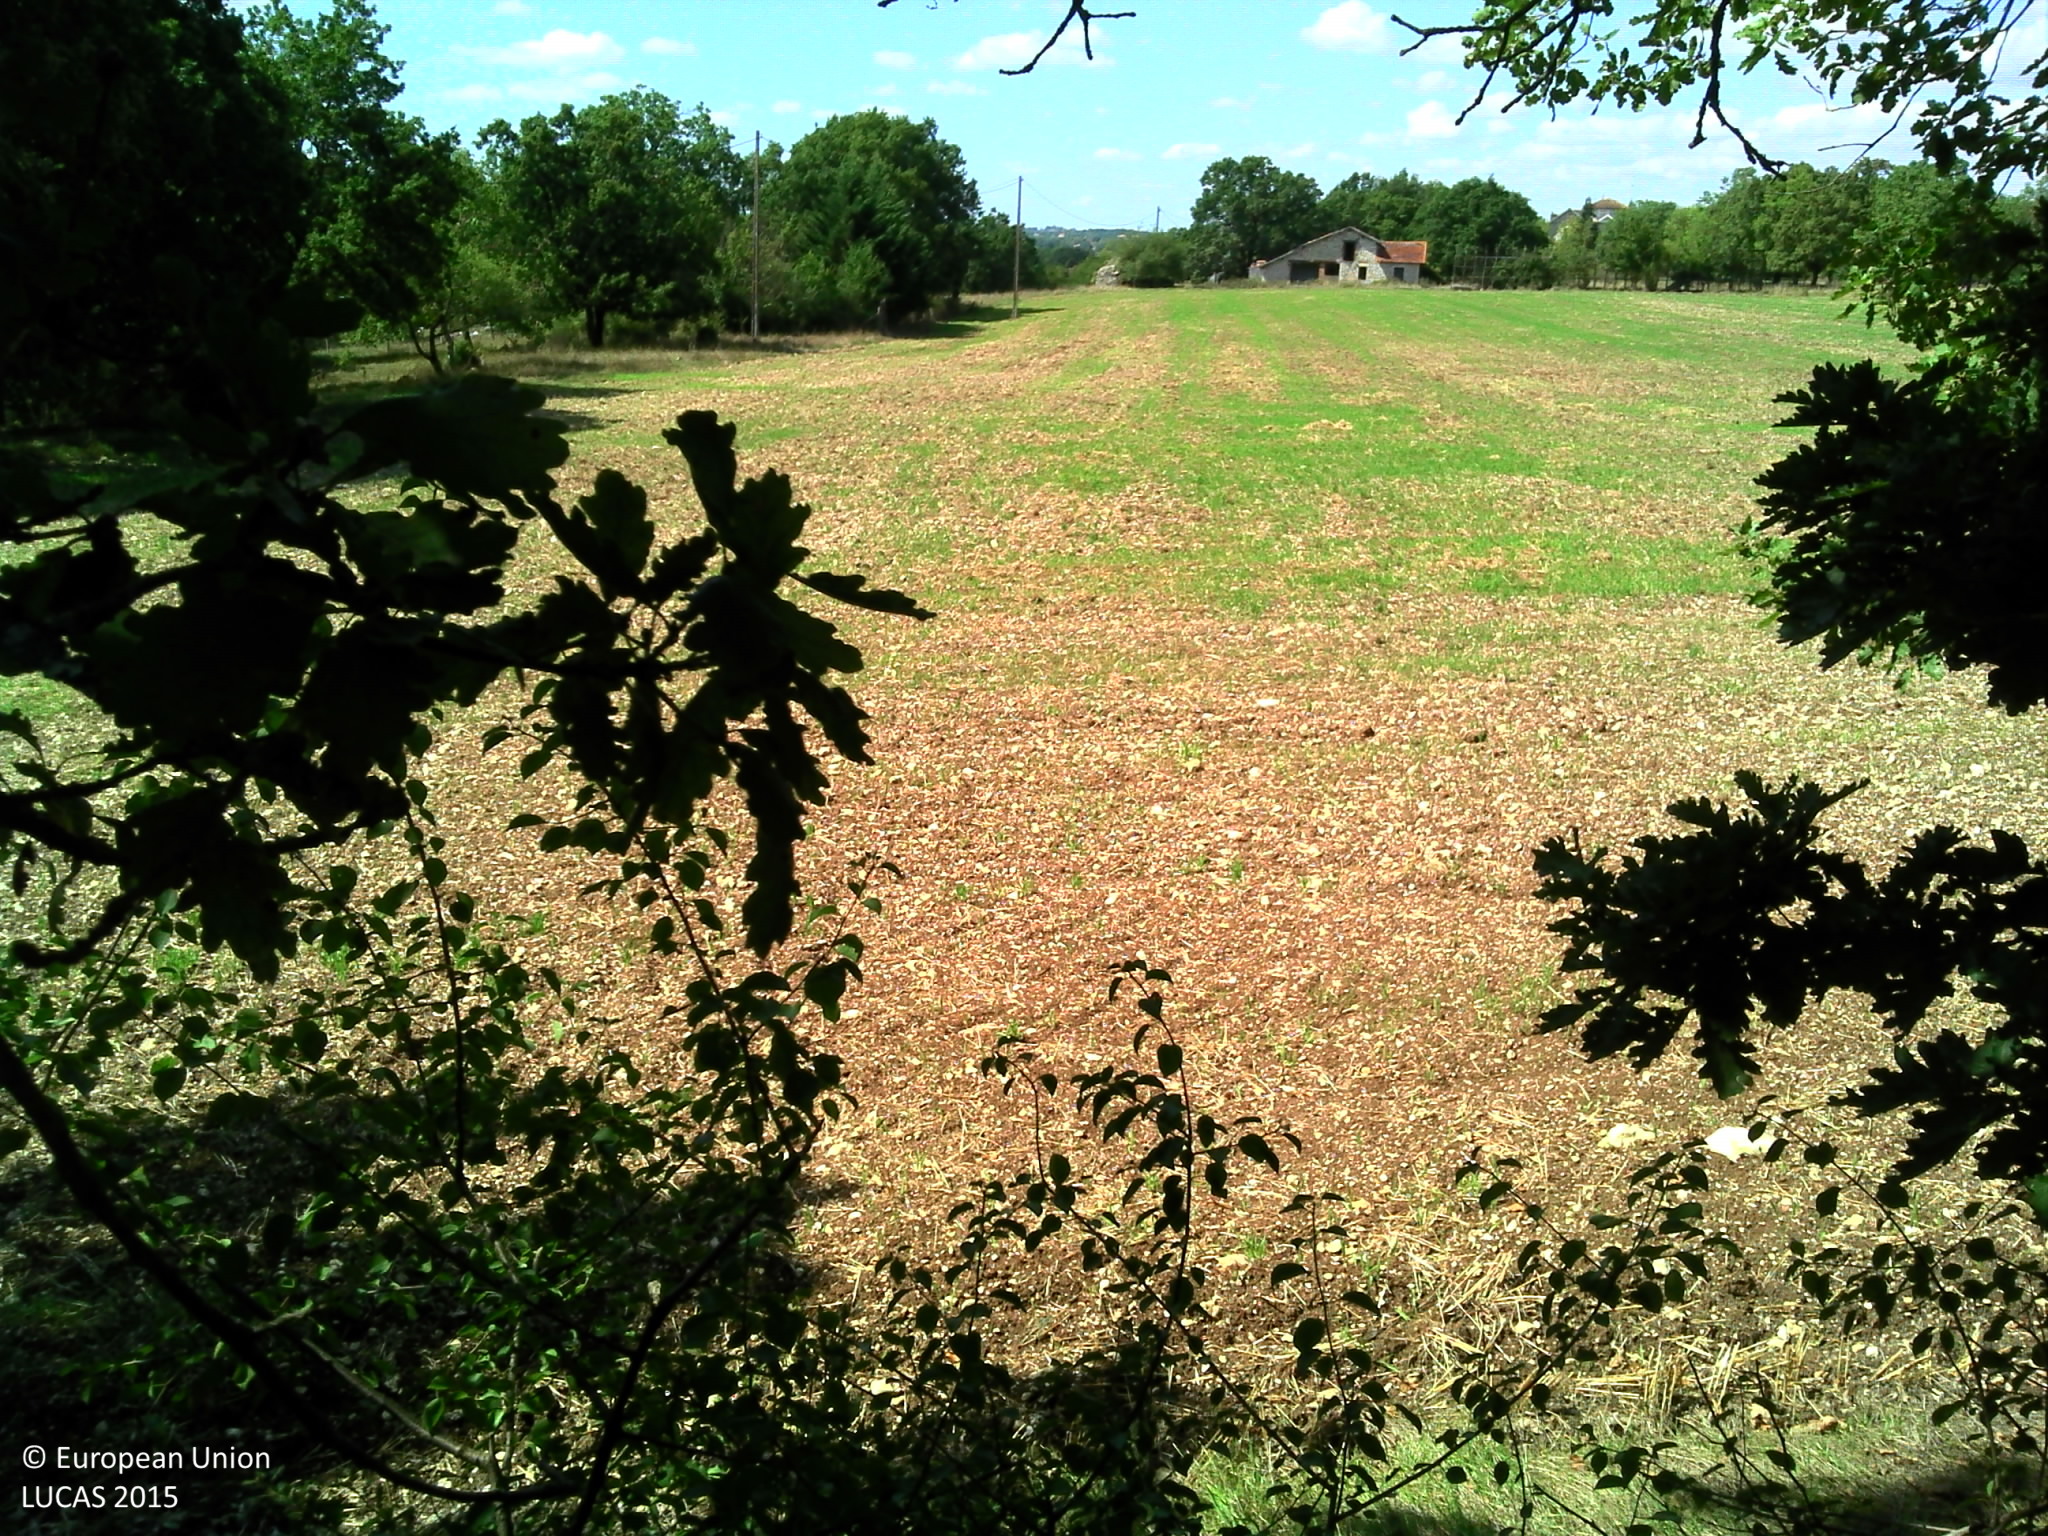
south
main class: Grassland
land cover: Spontaneously vegetated surfaces
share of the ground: 10 - 25 %
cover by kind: consolidated bare surface 75 %, herbaceous plants 25 %
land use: Agriculture (excluding fallow land and kitchen gardens)
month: August
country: FR
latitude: 44.2547
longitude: 1.4952
